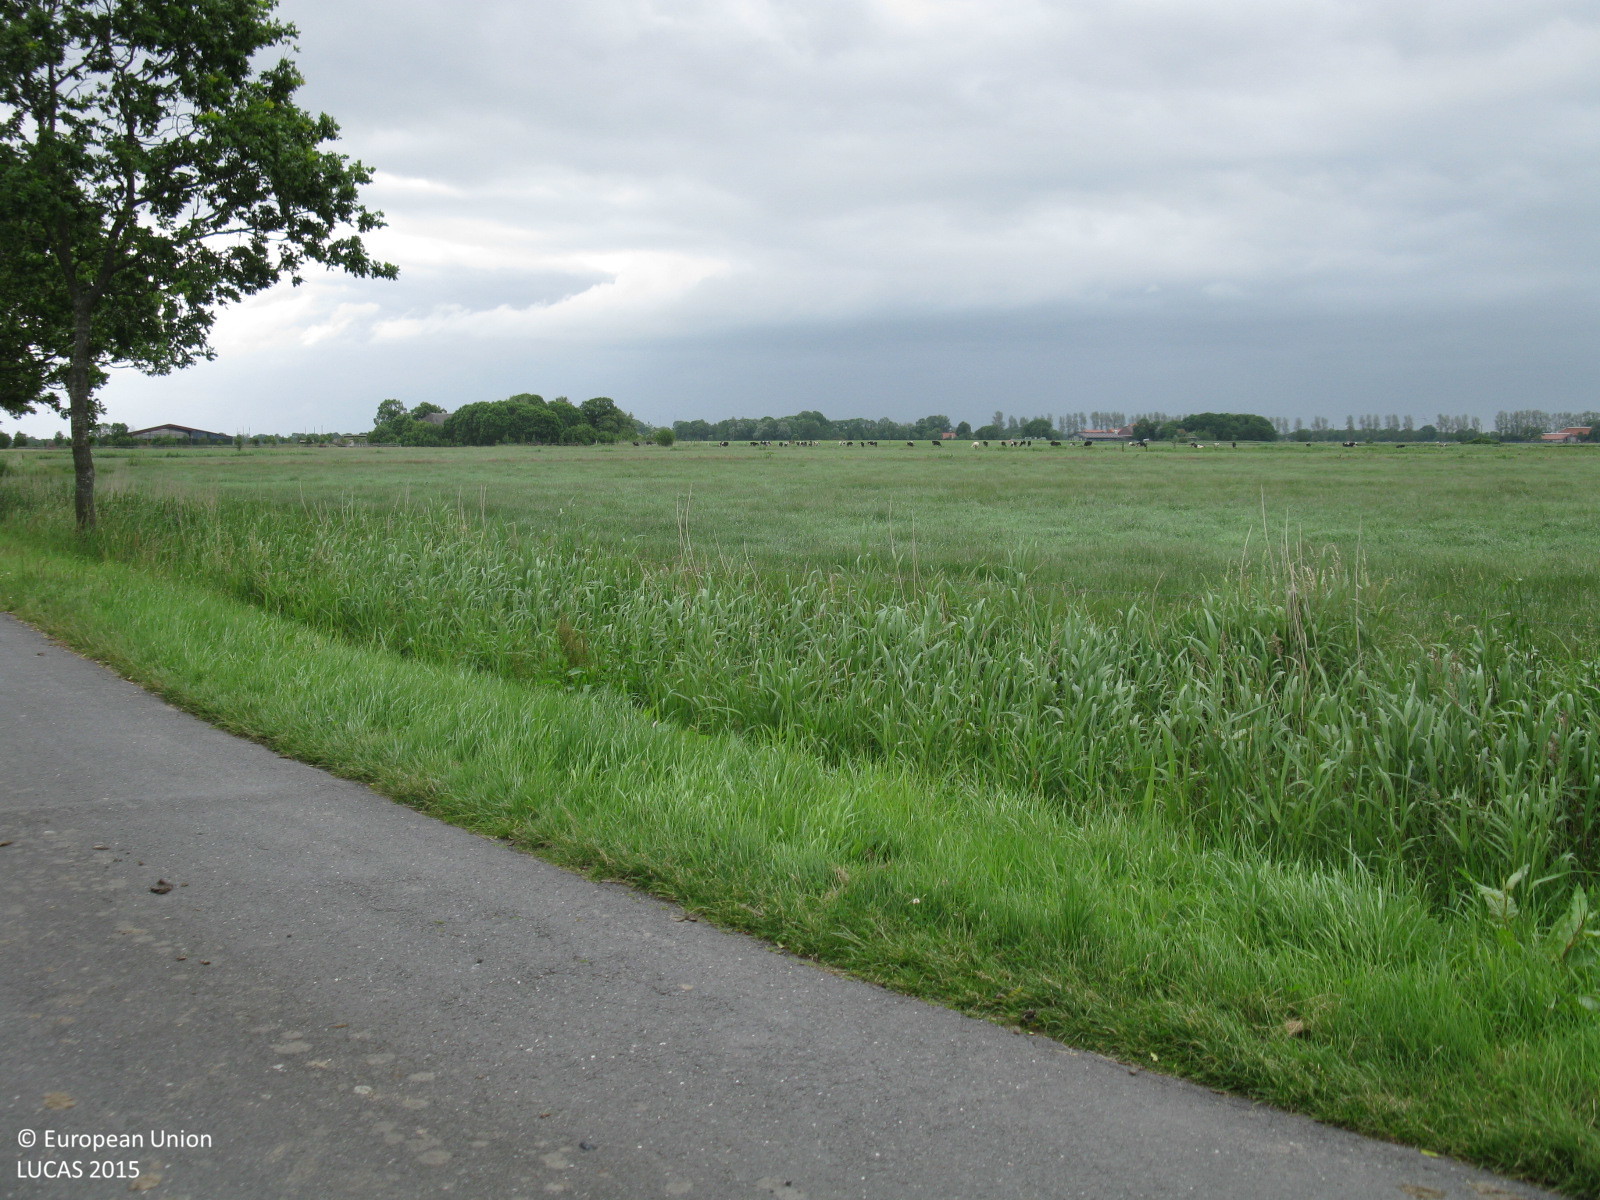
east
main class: Grassland
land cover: Grassland without tree/shrub cover
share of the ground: > 75 %
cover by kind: herbaceous plants 100 %
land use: Agriculture (excluding fallow land and kitchen gardens)
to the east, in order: Grassland without tree/shrub cover; Ditches and canals; Fences; Grassland without tree/shrub cover; Fences; Artificial constructions in urban areas
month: June
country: DE
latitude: 53.6175
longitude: 7.8995
